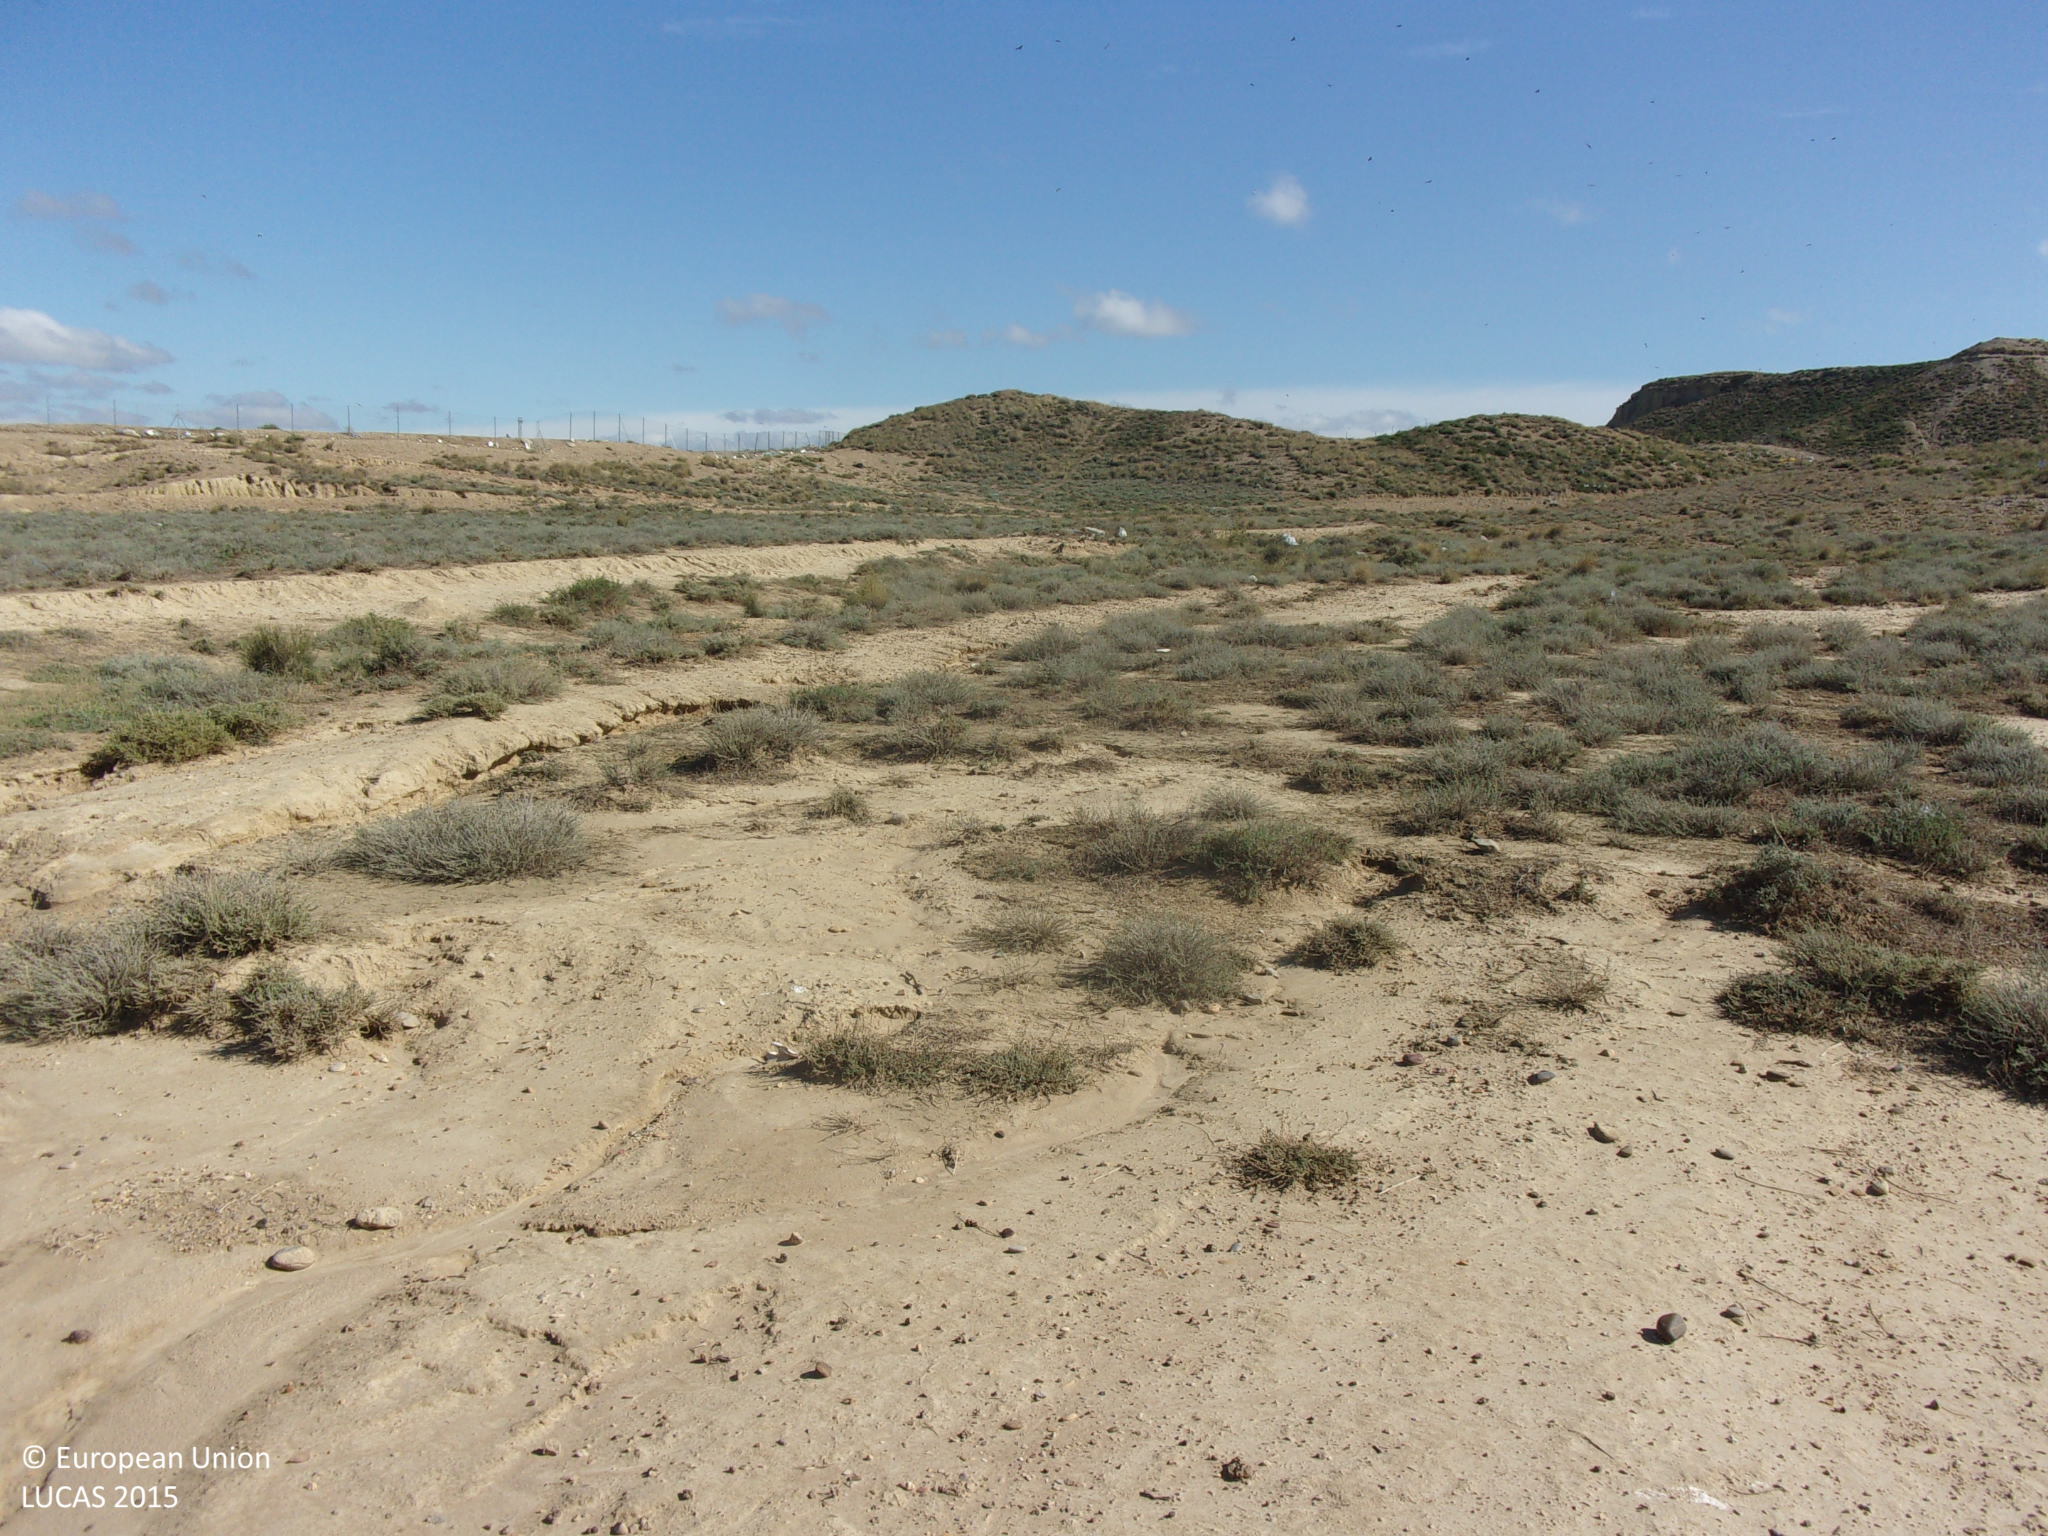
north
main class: Shrubland
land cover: Shrubland without tree cover
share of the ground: 10 - 25 %
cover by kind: consolidated bare surface 90 %, shrubs 10 %
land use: Abandoned areas
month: August
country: ES
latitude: 42.0923
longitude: -1.1388
